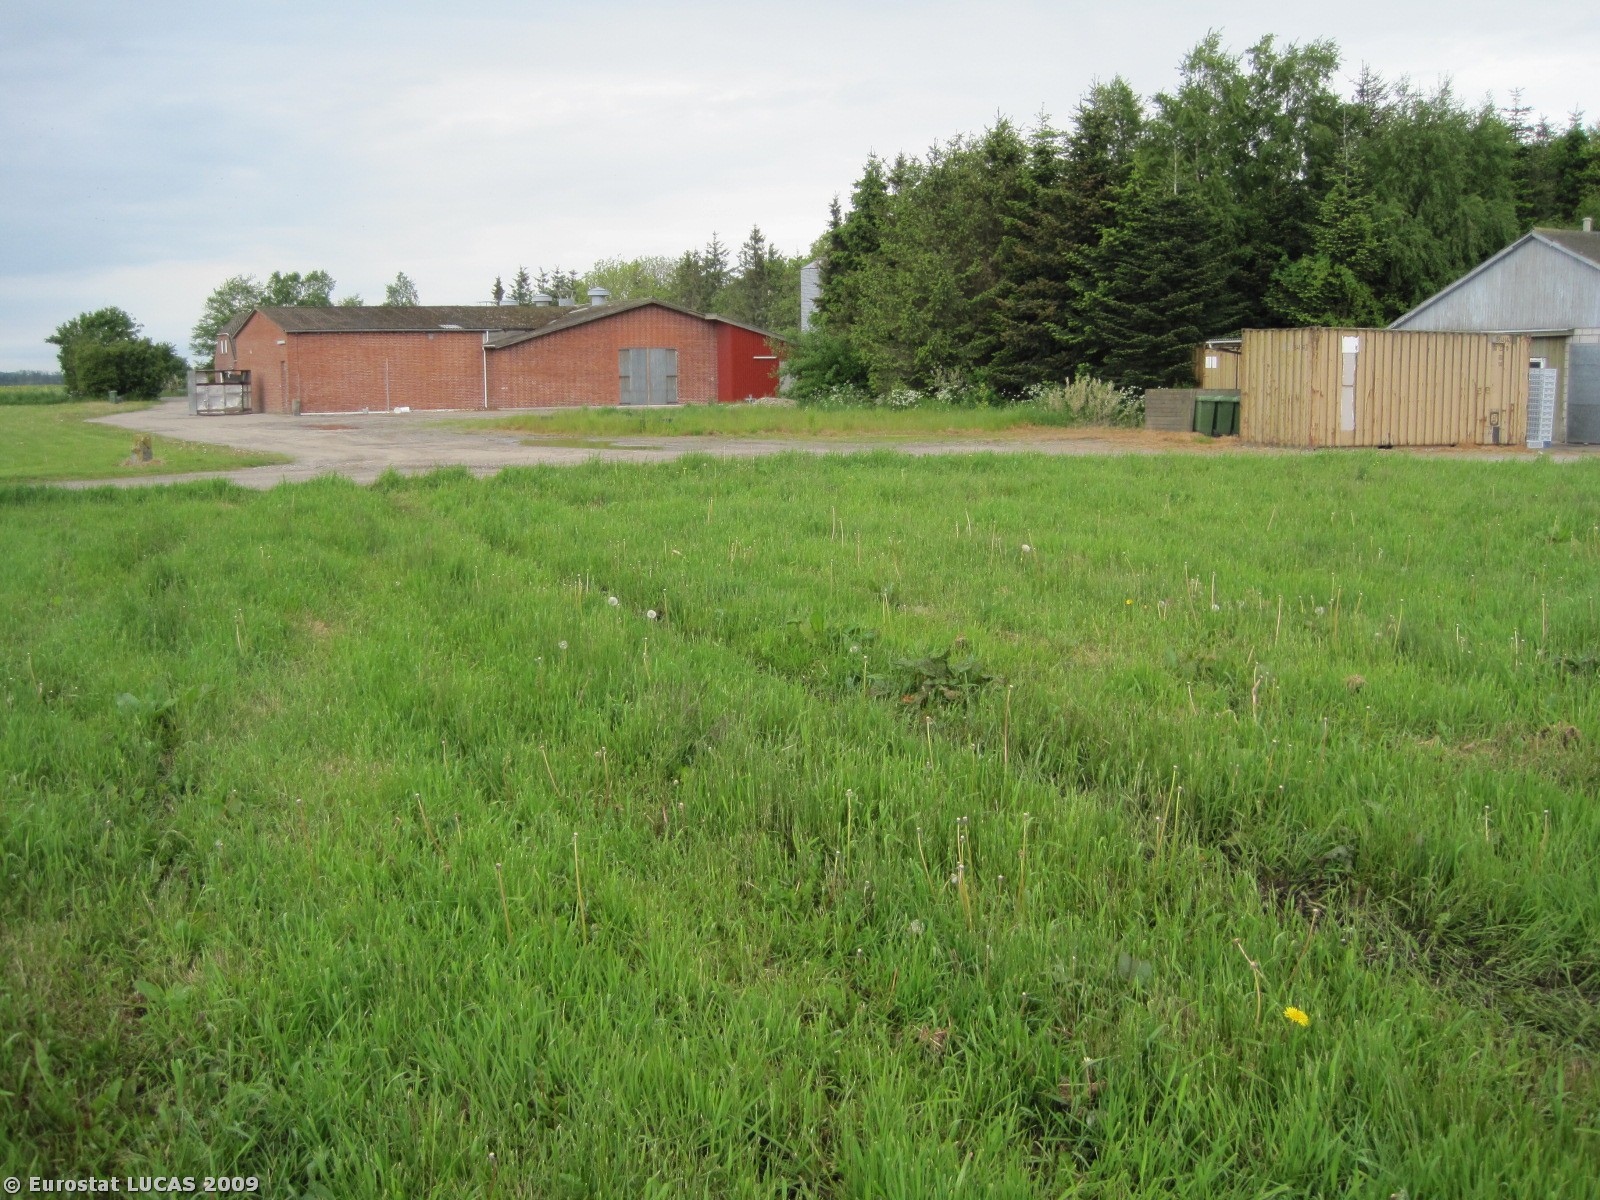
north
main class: Grassland
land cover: Grassland without tree/shrub cover
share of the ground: > 75 %
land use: Agriculture (excluding fallow land and kitchen gardens)
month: May
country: DK
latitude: 56.7808
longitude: 10.2125
